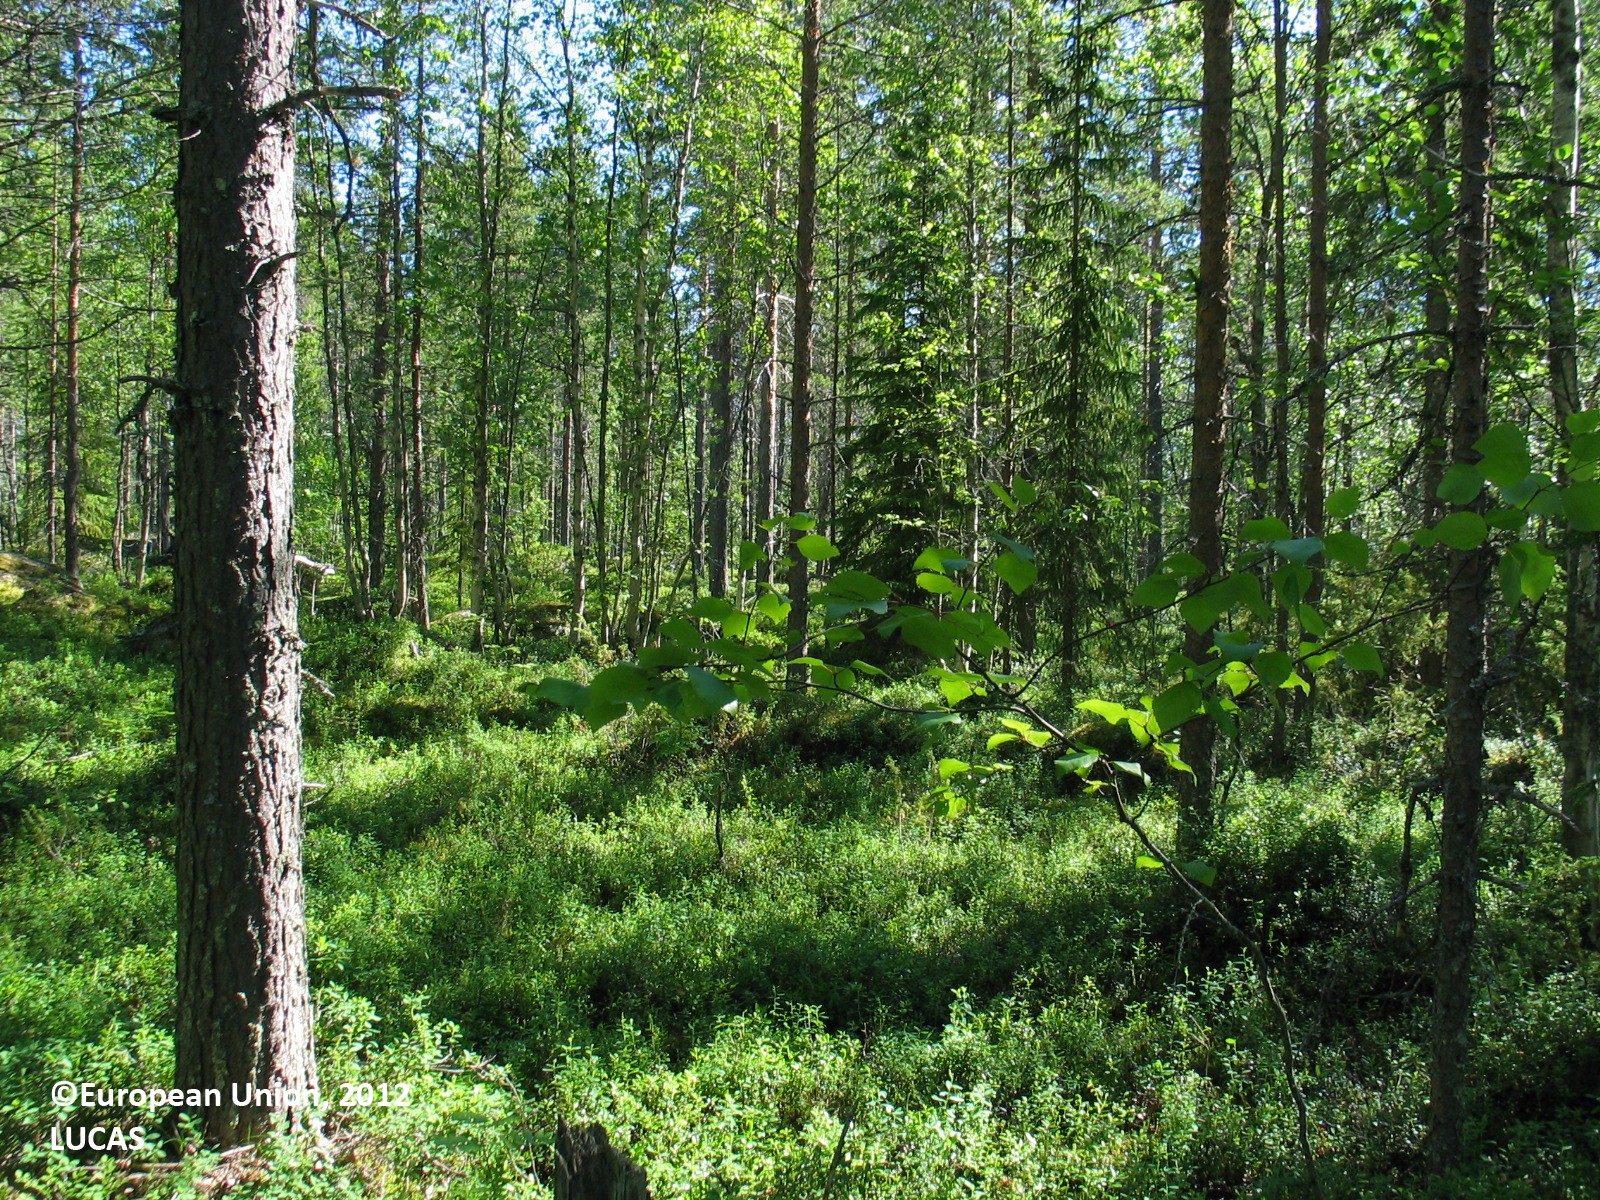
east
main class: Woodland
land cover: Pine dominated mixed woodland
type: boreal forest
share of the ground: 50 - 75 %
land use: Forestry
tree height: > 5 m
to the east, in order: Pine dominated mixed woodland; Pine dominated coniferous woodland; Shrubland without tree cover; Tracks; Pine dominated coniferous woodland
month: July
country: FI
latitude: 65.7828
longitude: 25.0297
